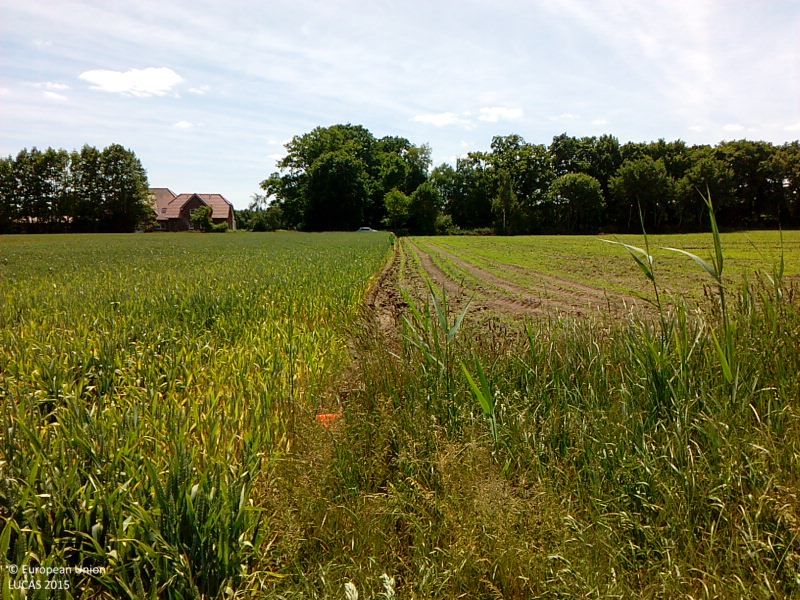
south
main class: Cropland
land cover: Common wheat
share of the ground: > 75 %
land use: Agriculture (excluding fallow land and kitchen gardens)
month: June
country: DE
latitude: 52.5473
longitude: 7.4197
